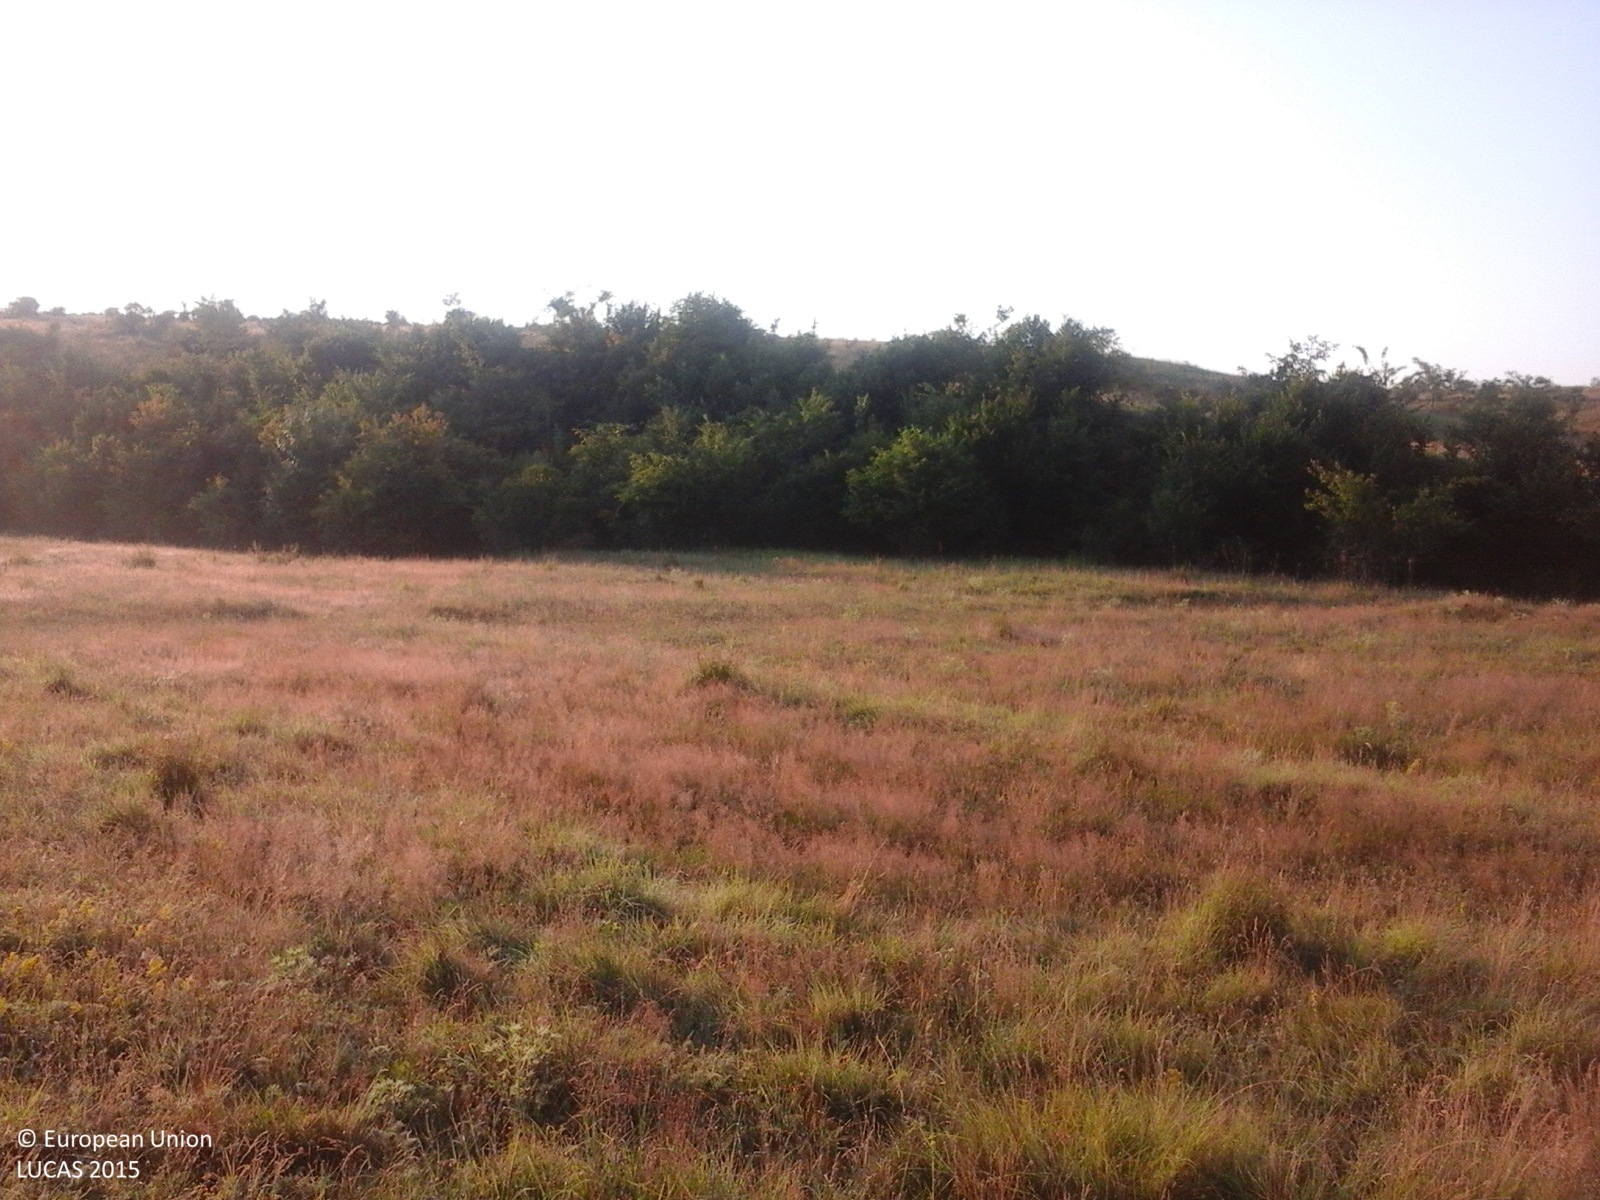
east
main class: Grassland
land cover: Grassland with sparse tree/shrub cover
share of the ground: > 75 %
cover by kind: herbaceous plants 85 %, shrubs 10 %, broadleaved forest trees 5 %
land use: Agriculture (excluding fallow land and kitchen gardens)
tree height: < 5 m
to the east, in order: Grassland with sparse tree/shrub cover; Tracks; Grassland without tree/shrub cover; Broadleaved woodland; Inland fresh running water; Broadleaved woodland; Grassland with sparse tree/shrub cover; Sunflower
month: July
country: RO
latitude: 44.6141
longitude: 24.7066
